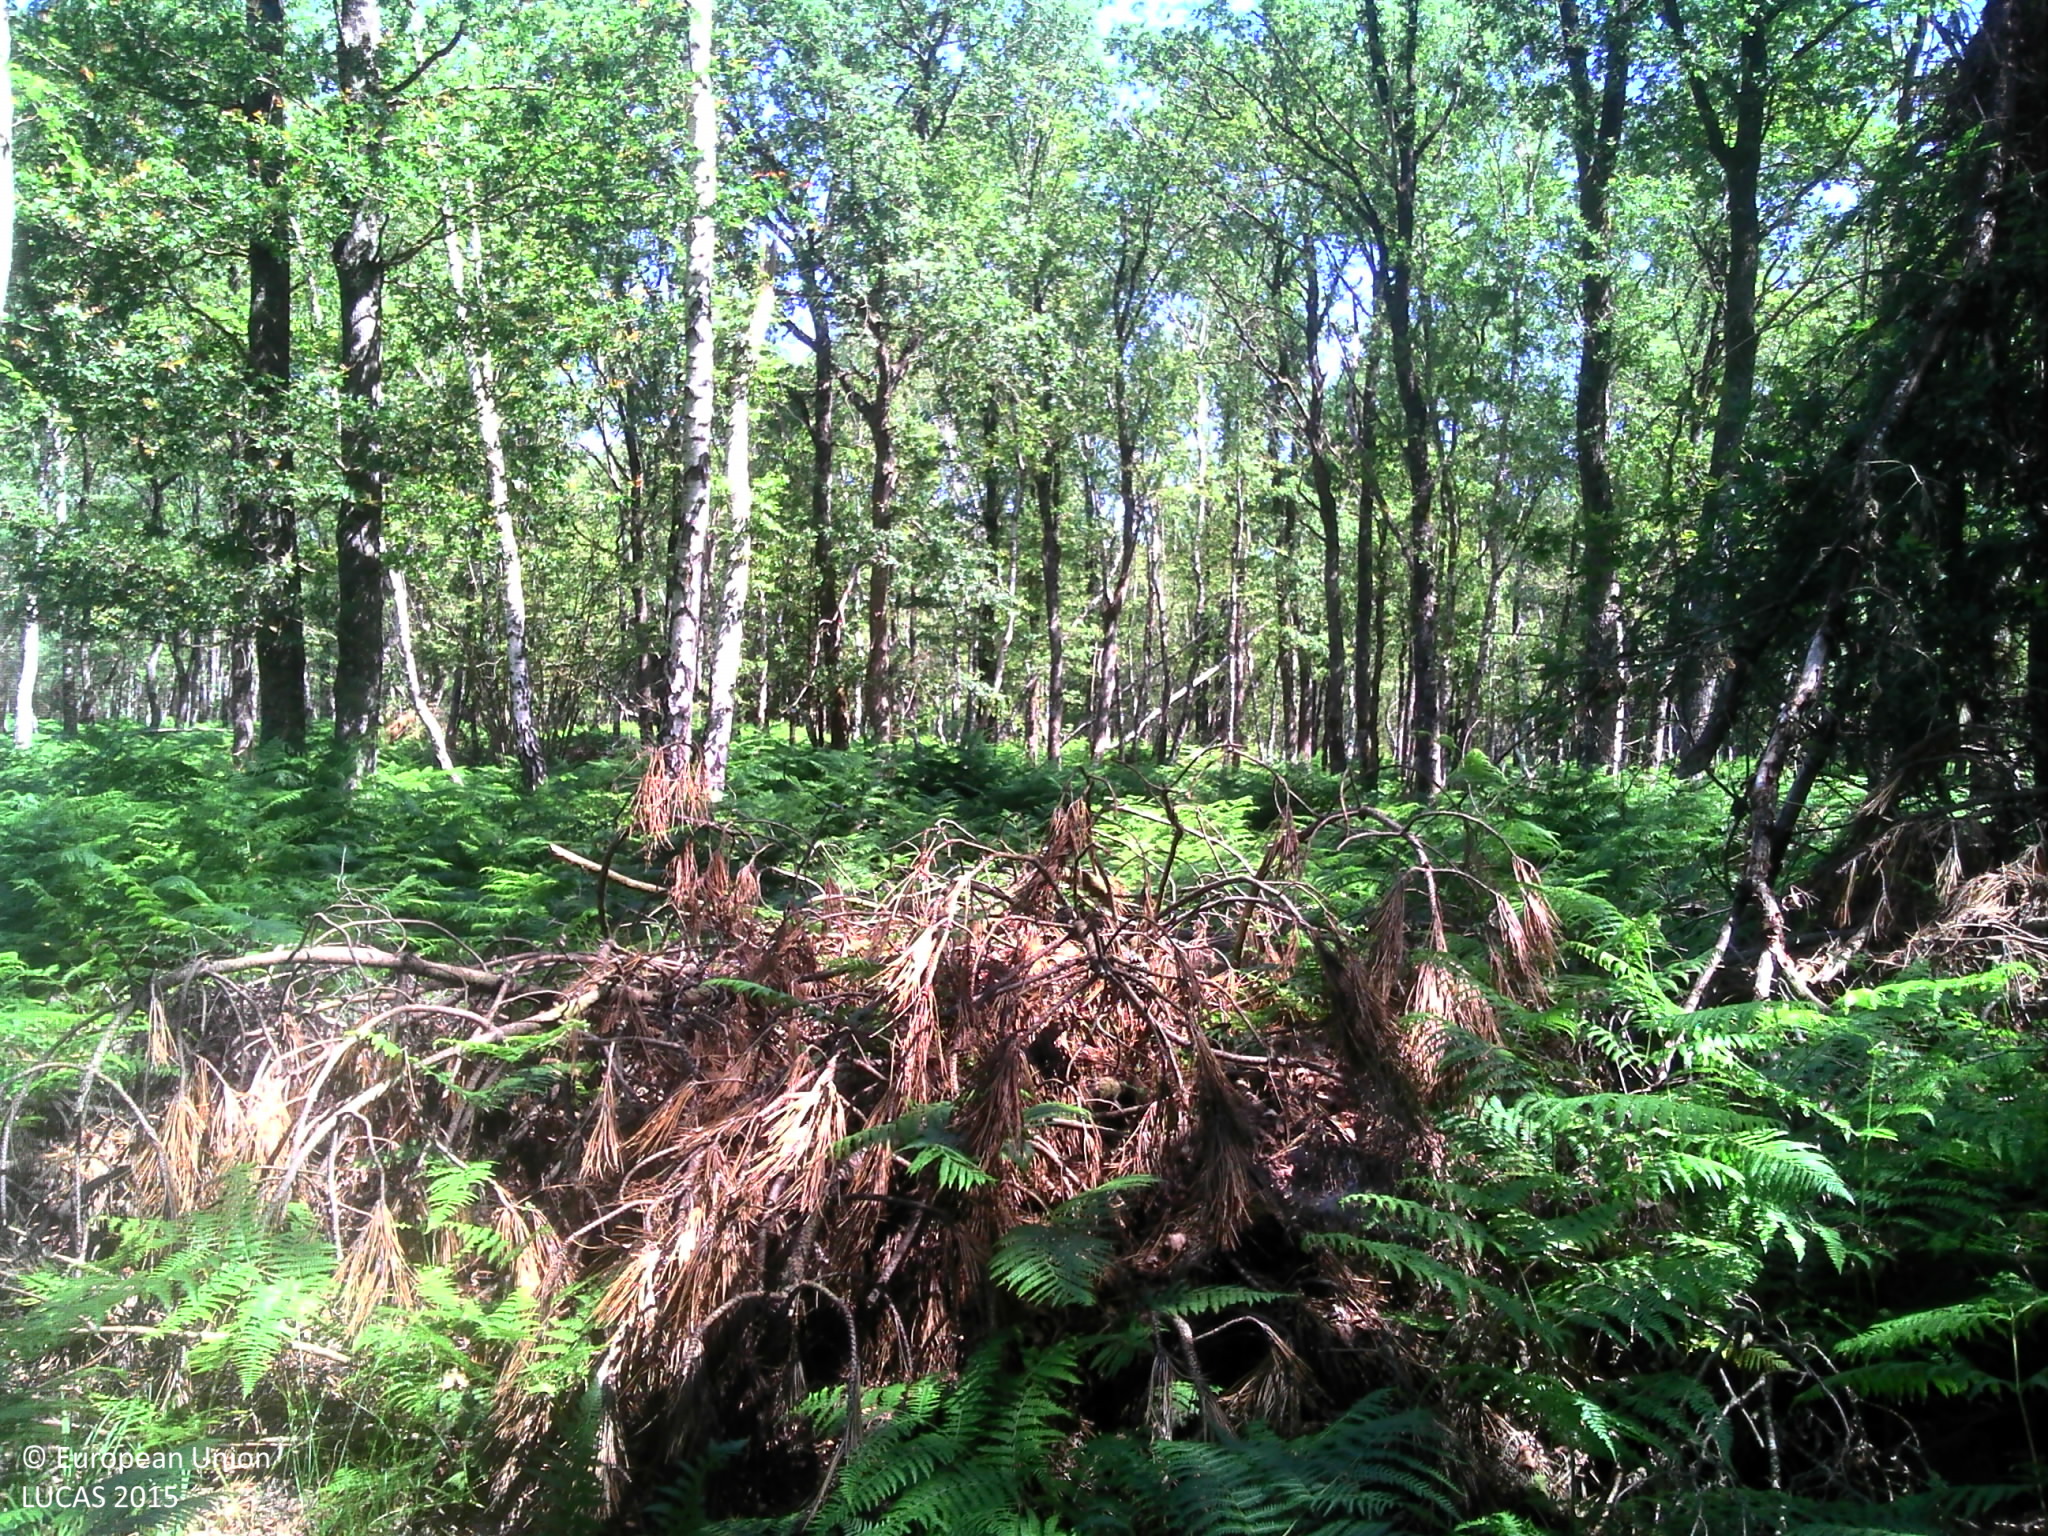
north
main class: Woodland
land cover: Broadleaved woodland
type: mesophytic deciduous forest
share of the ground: > 75 %
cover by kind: broadleaved forest trees 70 %, herbaceous plants 20 %, shrubs 5 %, lichens and mosses 5 %
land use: Forestry
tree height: > 5 m
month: June
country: FR
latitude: 47.3621
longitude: 0.3251
